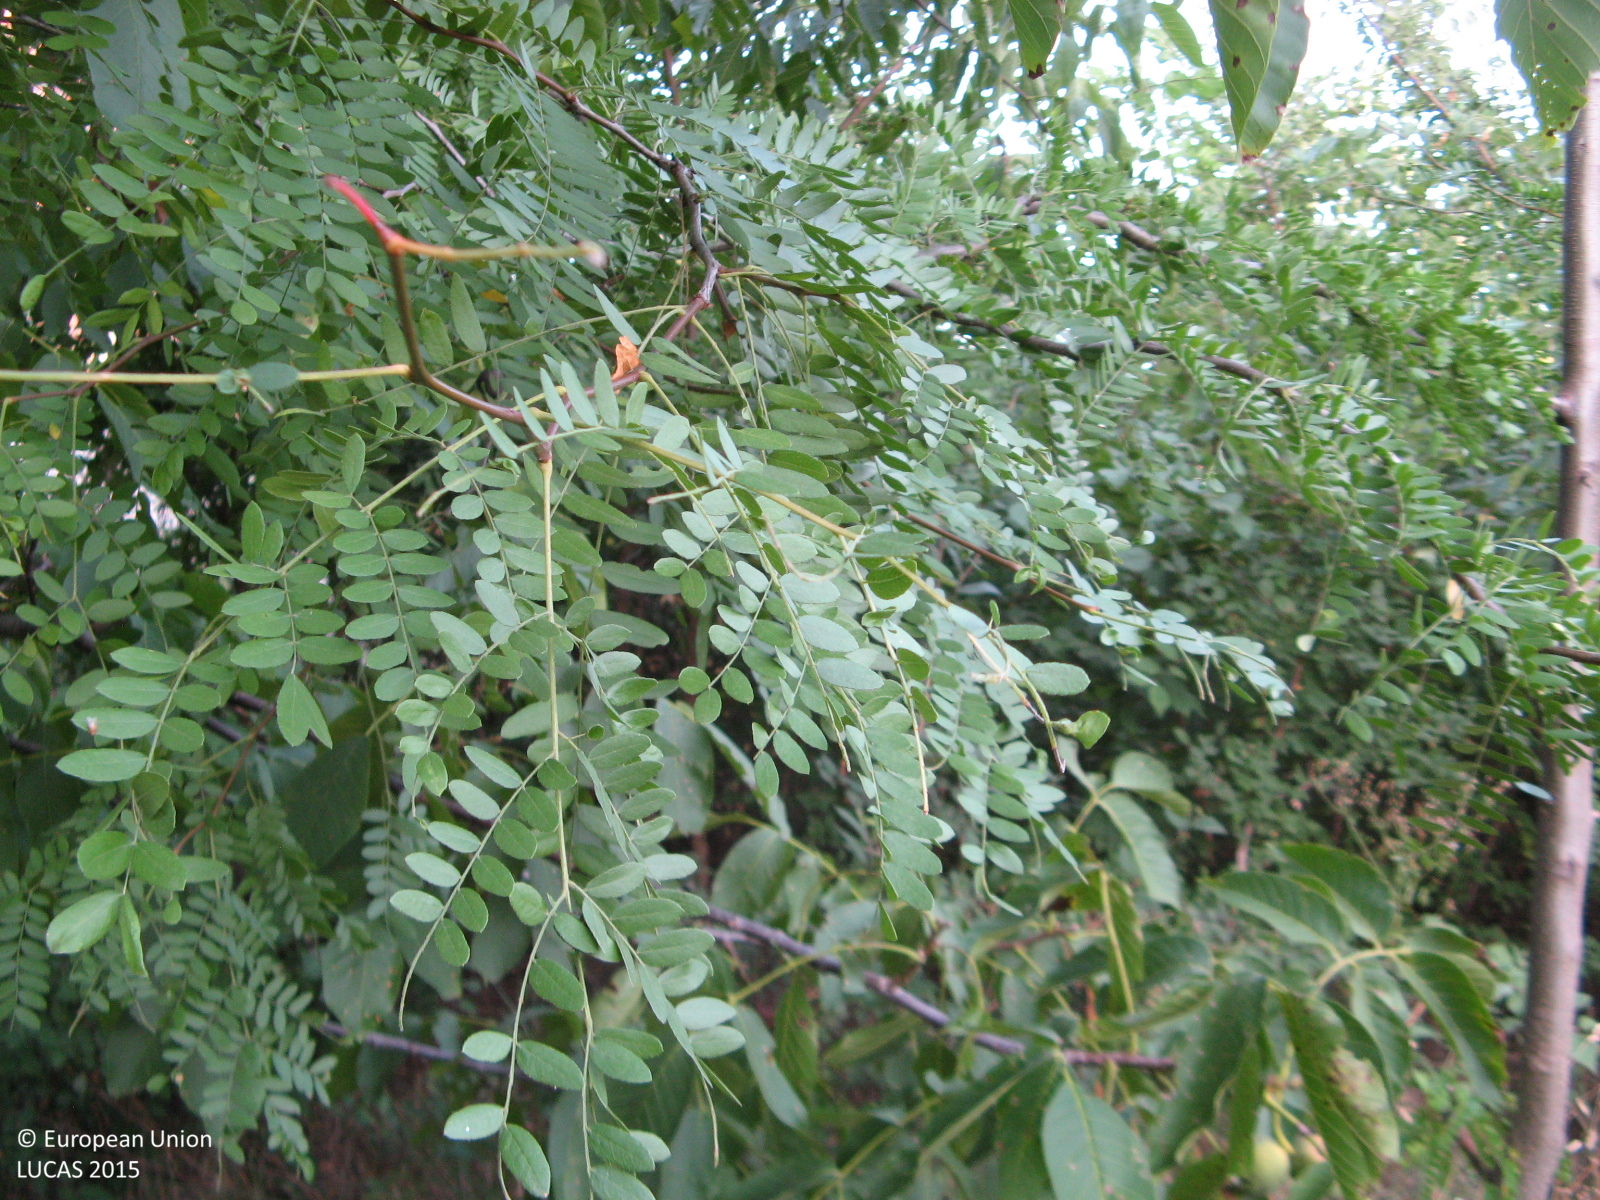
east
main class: Woodland
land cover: Broadleaved woodland
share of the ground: 25 - 50 %
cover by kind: broadleaved forest trees 45 %, herbaceous plants 45 %, shrubs 10 %
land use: Residential
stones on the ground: < 10 %
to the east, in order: Broadleaved woodland; Artificial constructions in urban areas; Broadleaved woodland; Grassland without tree/shrub cover; Broadleaved woodland
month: August
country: BG
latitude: 43.5993
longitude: 25.3790
